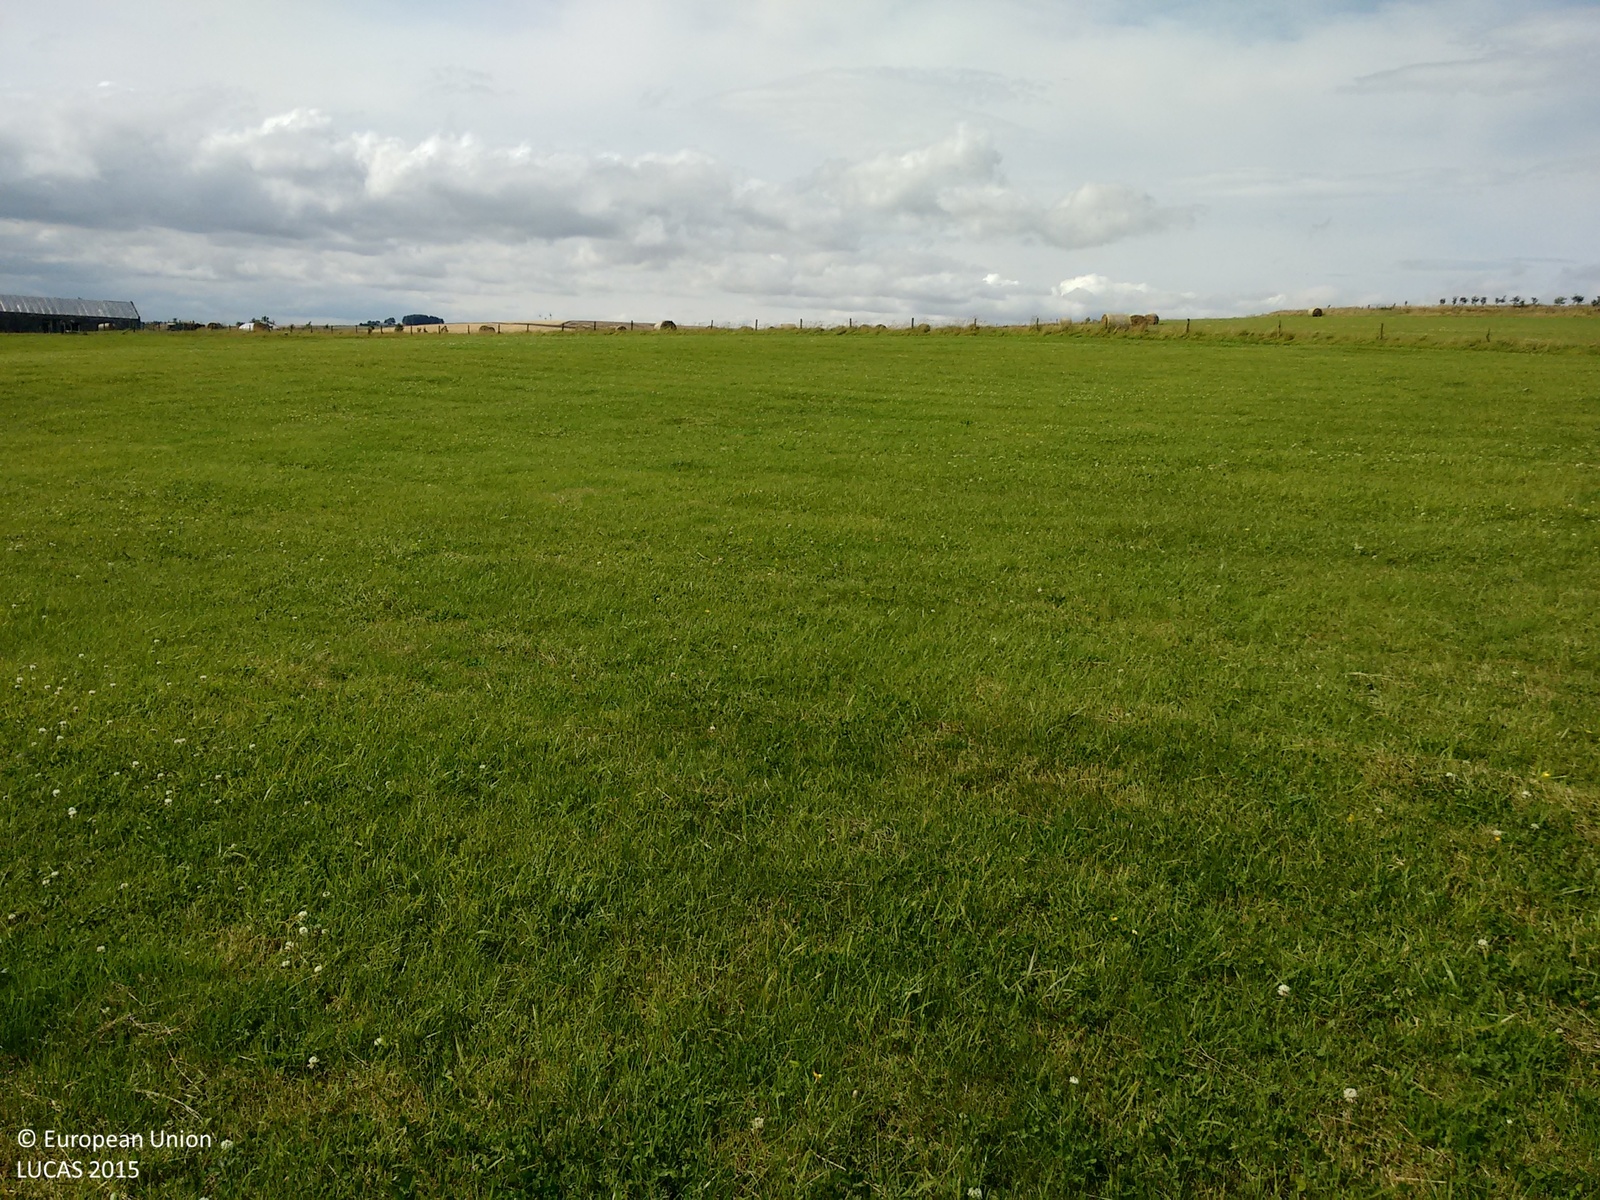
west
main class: Grassland
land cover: Grassland without tree/shrub cover
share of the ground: > 75 %
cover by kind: herbaceous plants 100 %
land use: Agriculture (excluding fallow land and kitchen gardens)
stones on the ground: 10 - 25 %
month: August
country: GB
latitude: 57.6228
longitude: -2.2203
